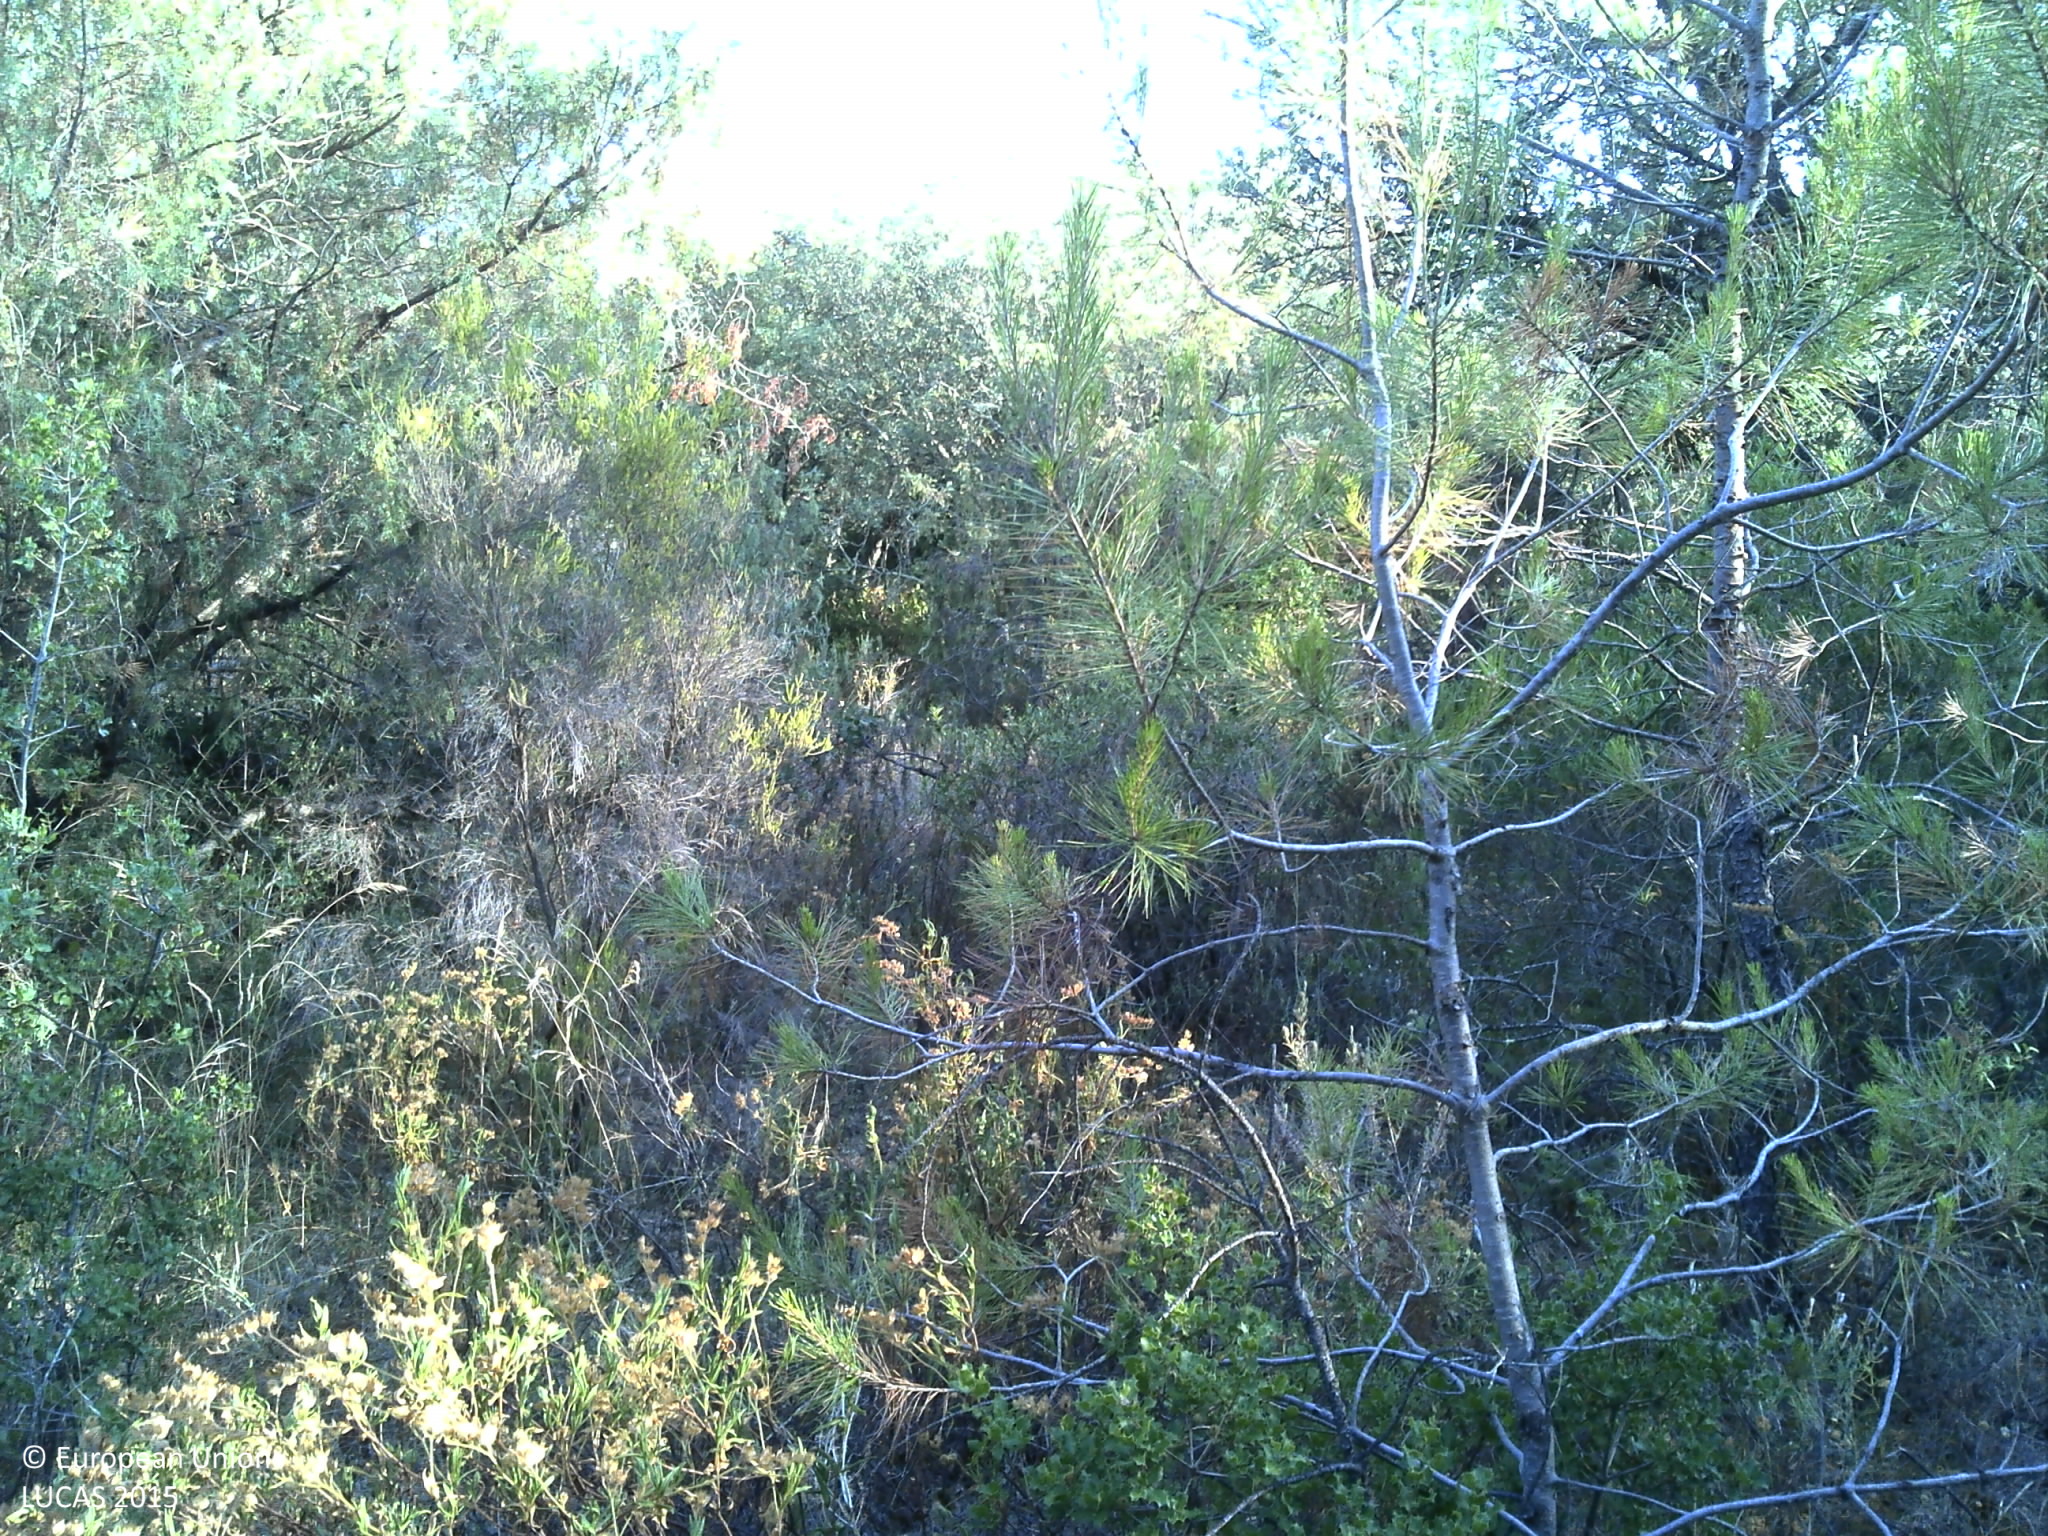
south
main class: Woodland
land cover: Other mixed woodland
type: broadleaved evergreen forest
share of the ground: > 75 %
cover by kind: broadleaved forest trees 35 %, herbaceous plants 30 %, coniferous forest trees 25 %, unconsolidated bare surface 10 %
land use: Forestry
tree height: < 5 m
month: July
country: FR
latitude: 43.6838
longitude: 3.6199
